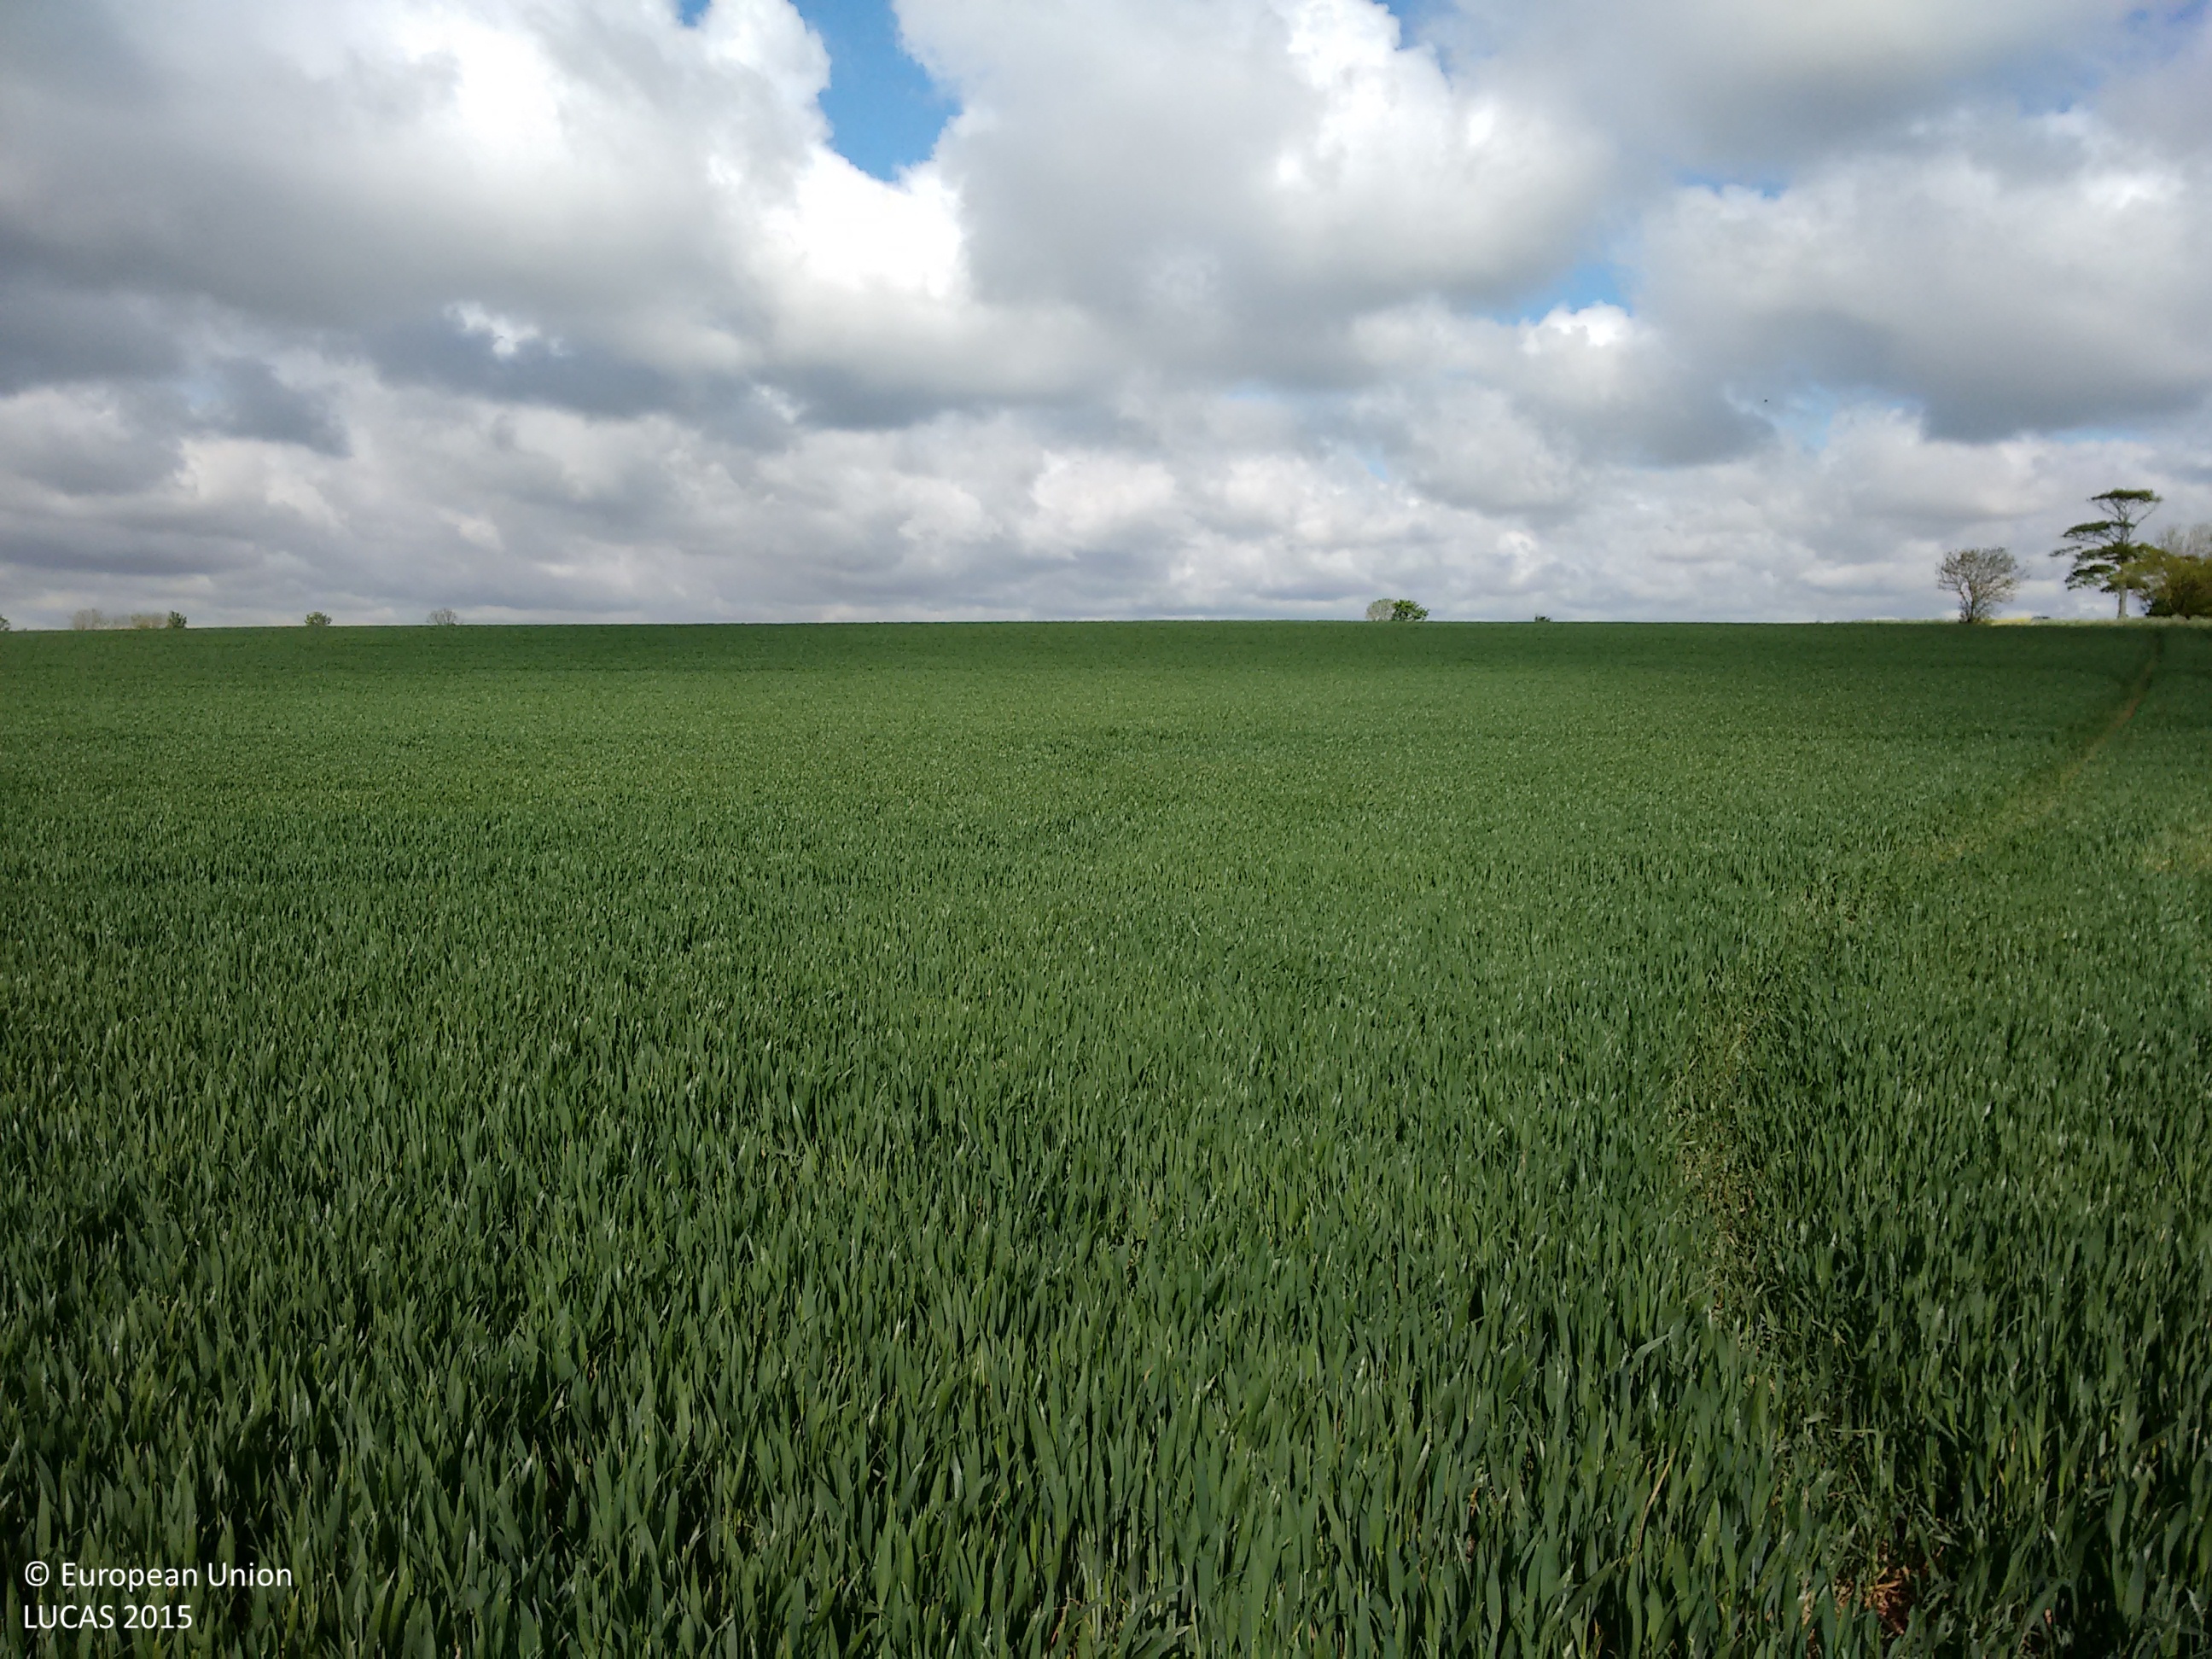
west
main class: Cropland
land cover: Common wheat
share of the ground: > 75 %
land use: Agriculture (excluding fallow land and kitchen gardens)
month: May
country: GB
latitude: 53.7386
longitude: -0.1145
